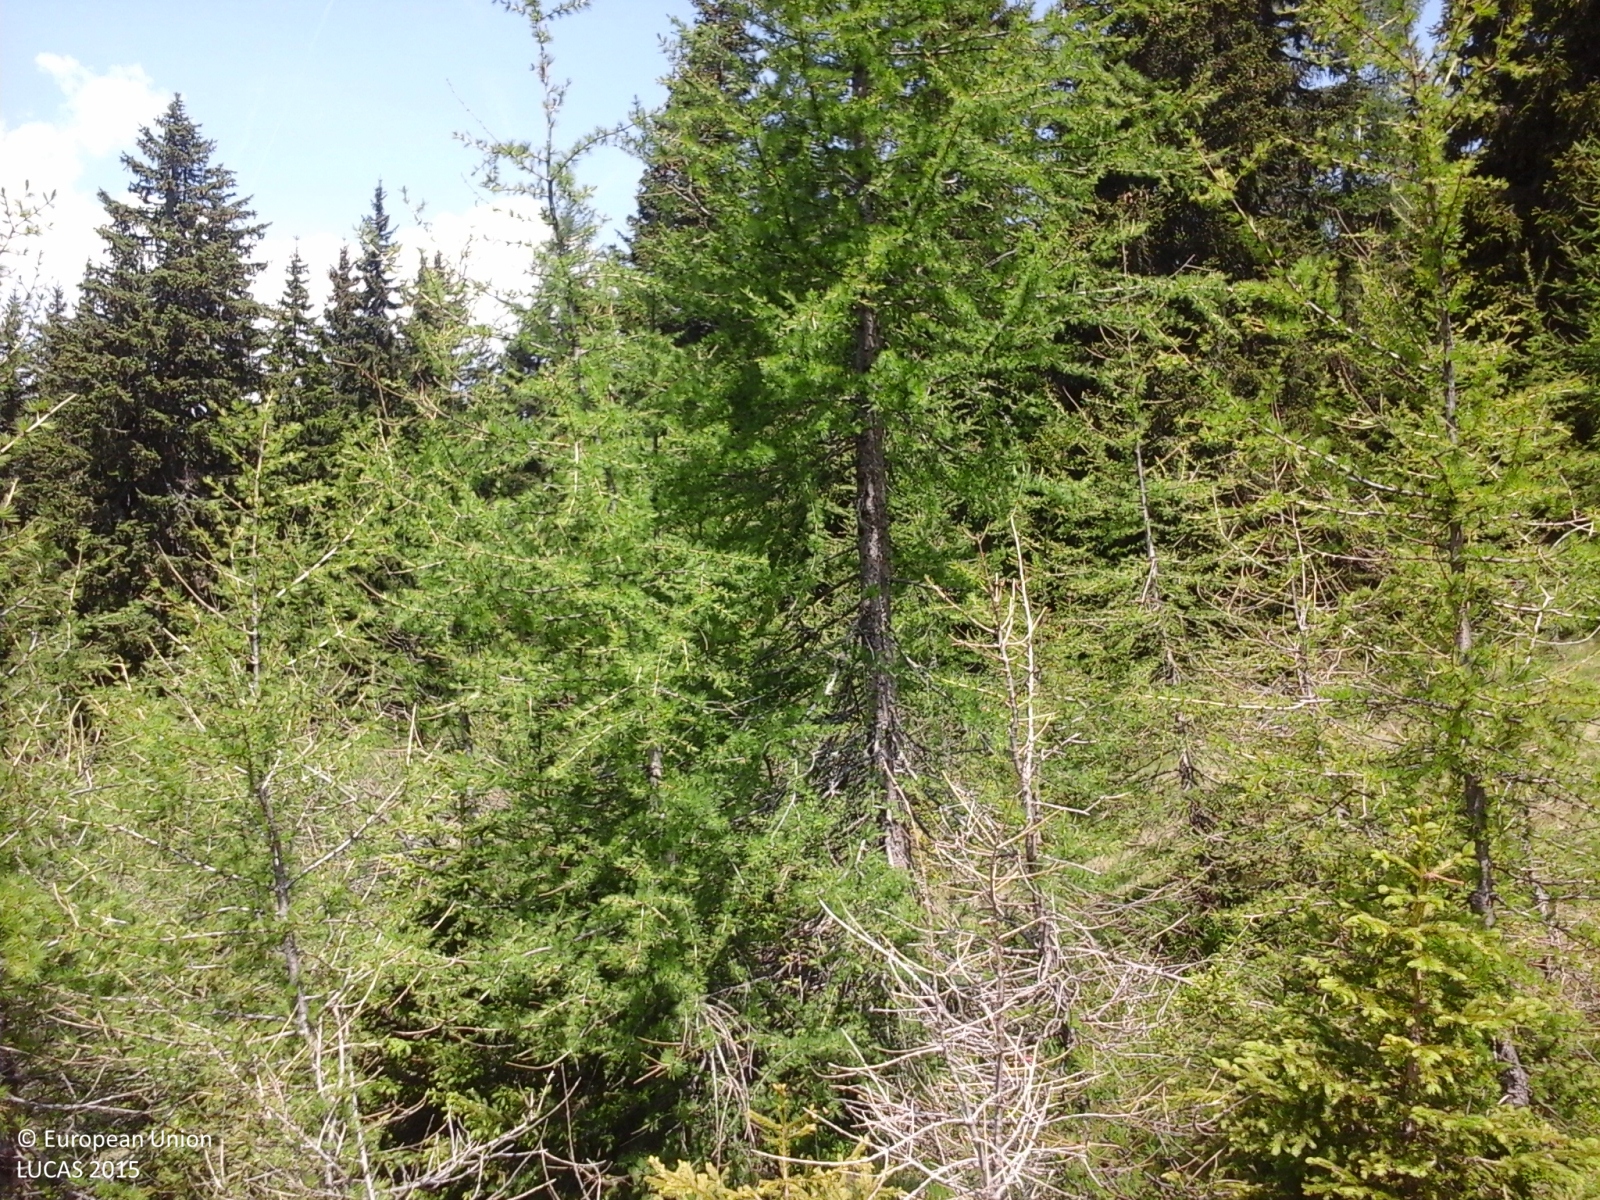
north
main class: Grassland
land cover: Grassland with sparse tree/shrub cover
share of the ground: > 75 %
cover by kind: herbaceous plants 95 %, coniferous forest trees 5 %
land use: Agriculture (excluding fallow land and kitchen gardens)
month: June
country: IT
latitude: 46.7403
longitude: 11.2419
